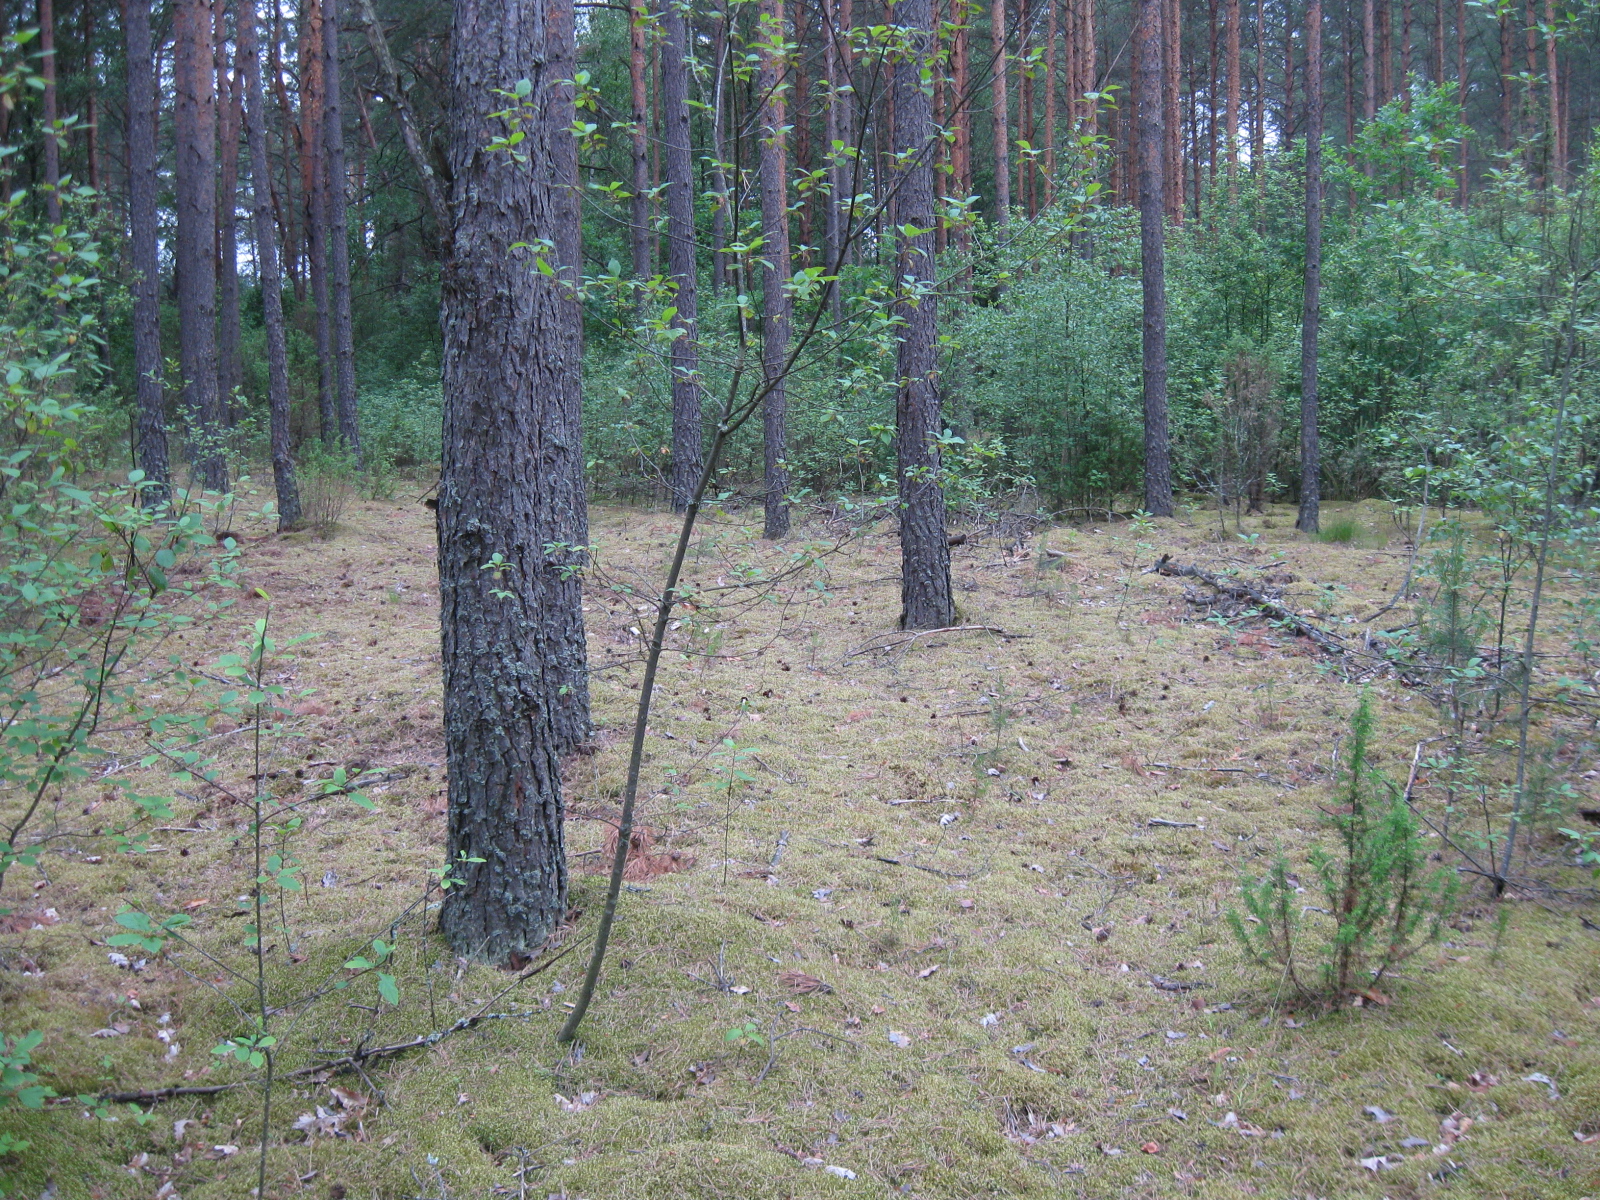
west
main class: Woodland
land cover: Pine dominated mixed woodland
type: hemiboreal forest and nemoral coniferous forest and mixed broadleaved-coniferous forest
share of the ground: > 75 %
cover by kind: coniferous forest trees 50 %, broadleaved forest trees 30 %, lichens and mosses 20 %
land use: Forestry
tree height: > 5 m
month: July
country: LT
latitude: 54.1037
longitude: 24.2761
